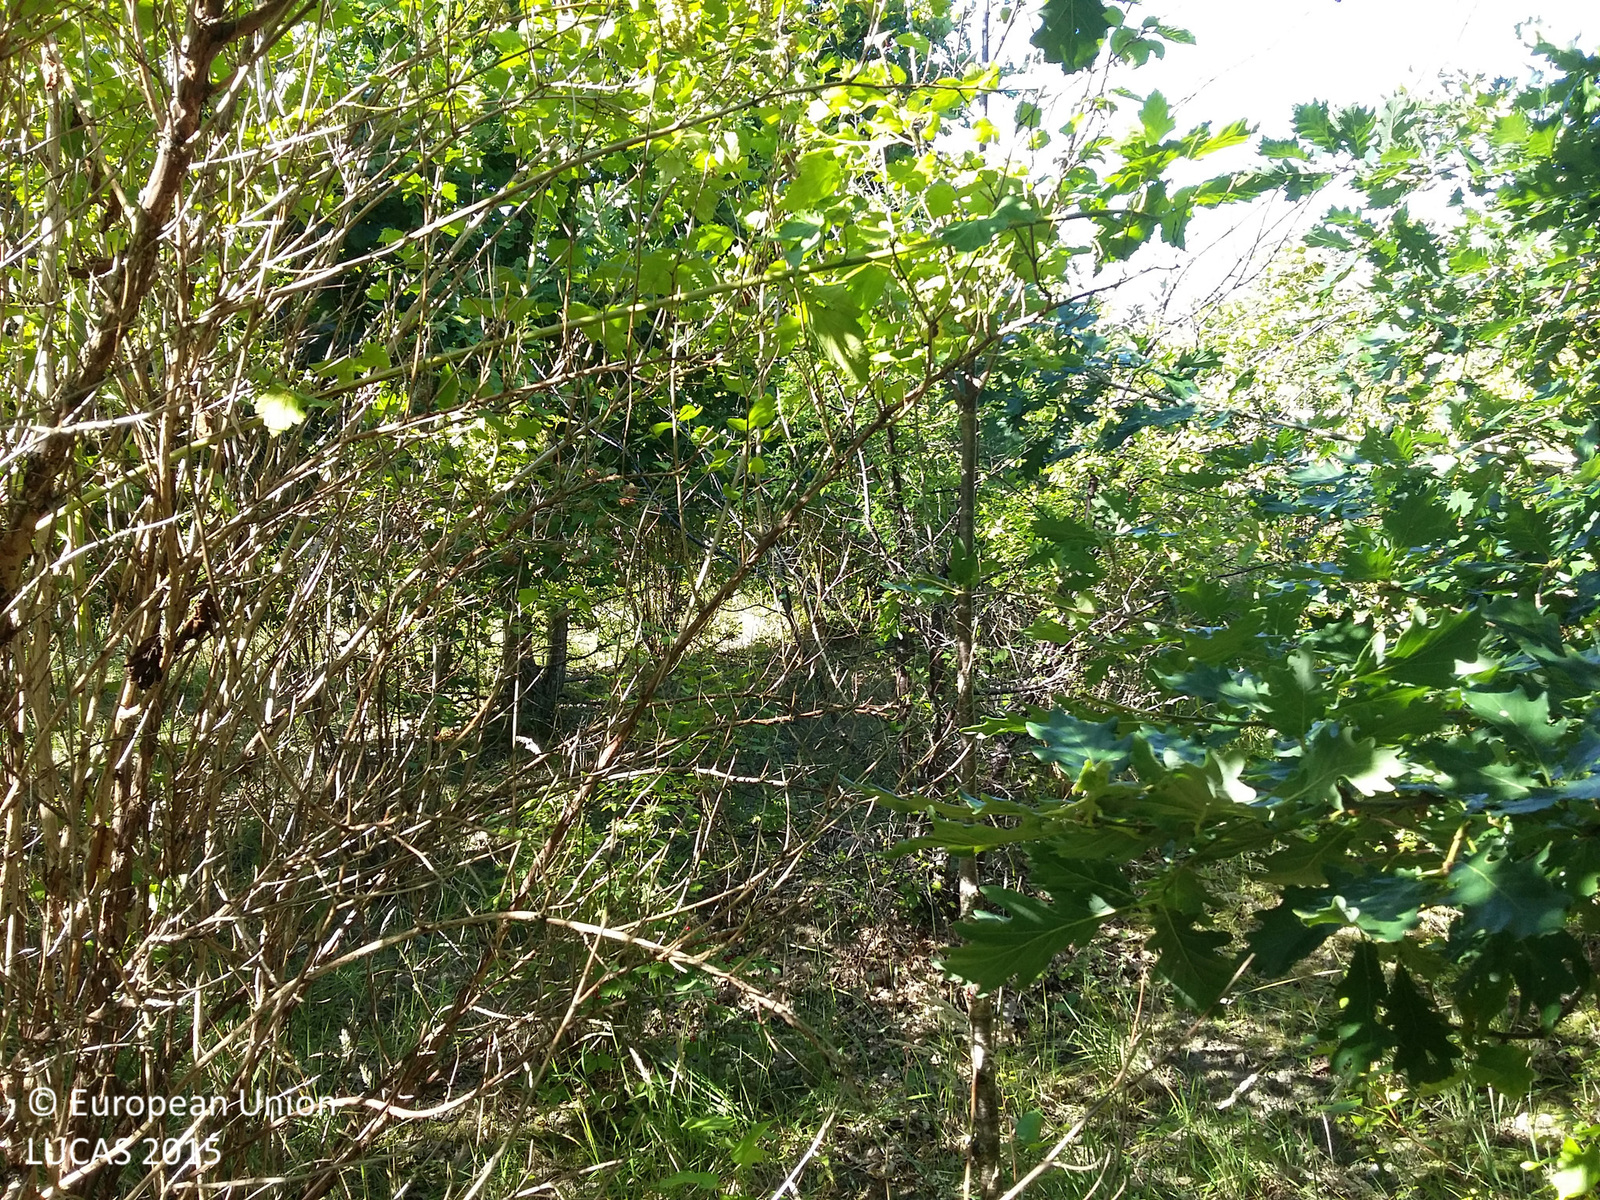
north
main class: Woodland
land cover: Broadleaved woodland
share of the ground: > 75 %
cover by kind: broadleaved forest trees 80 %, herbaceous plants 20 %
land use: Semi-natural and natural areas not in use
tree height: > 5 m
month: August
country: DK
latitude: 55.6849
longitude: 12.1136
